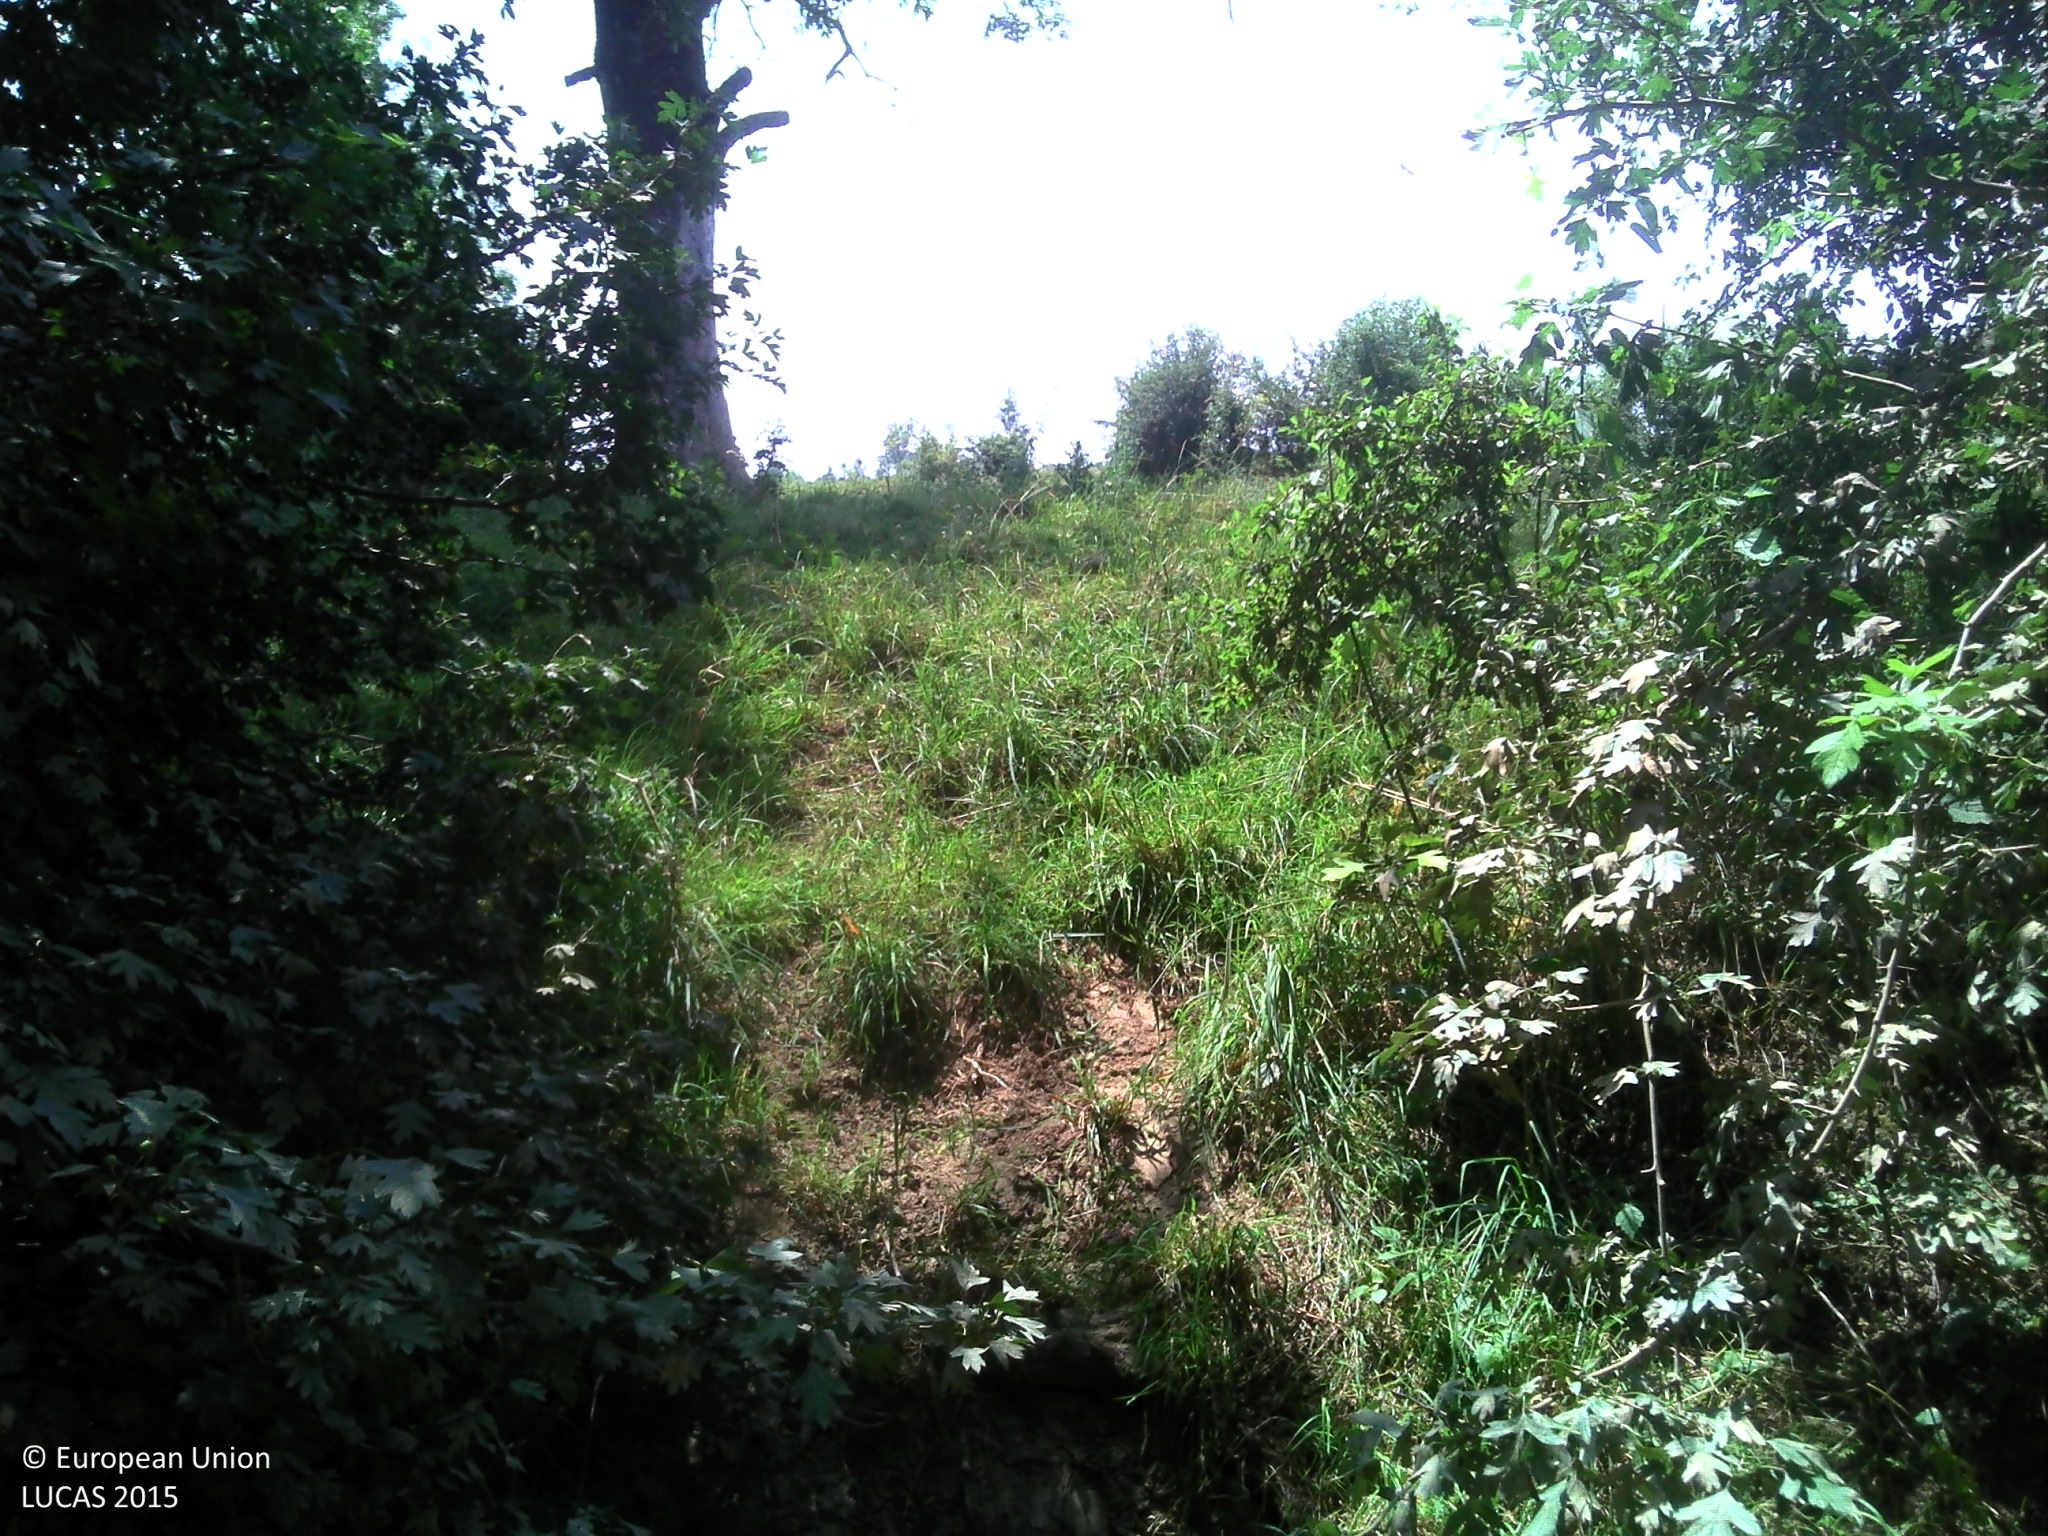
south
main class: Woodland
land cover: Broadleaved woodland
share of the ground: > 75 %
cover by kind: broadleaved forest trees 70 %, herbaceous plants 30 %
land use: Abandoned areas
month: July
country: FR
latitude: 46.9328
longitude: 5.2862
